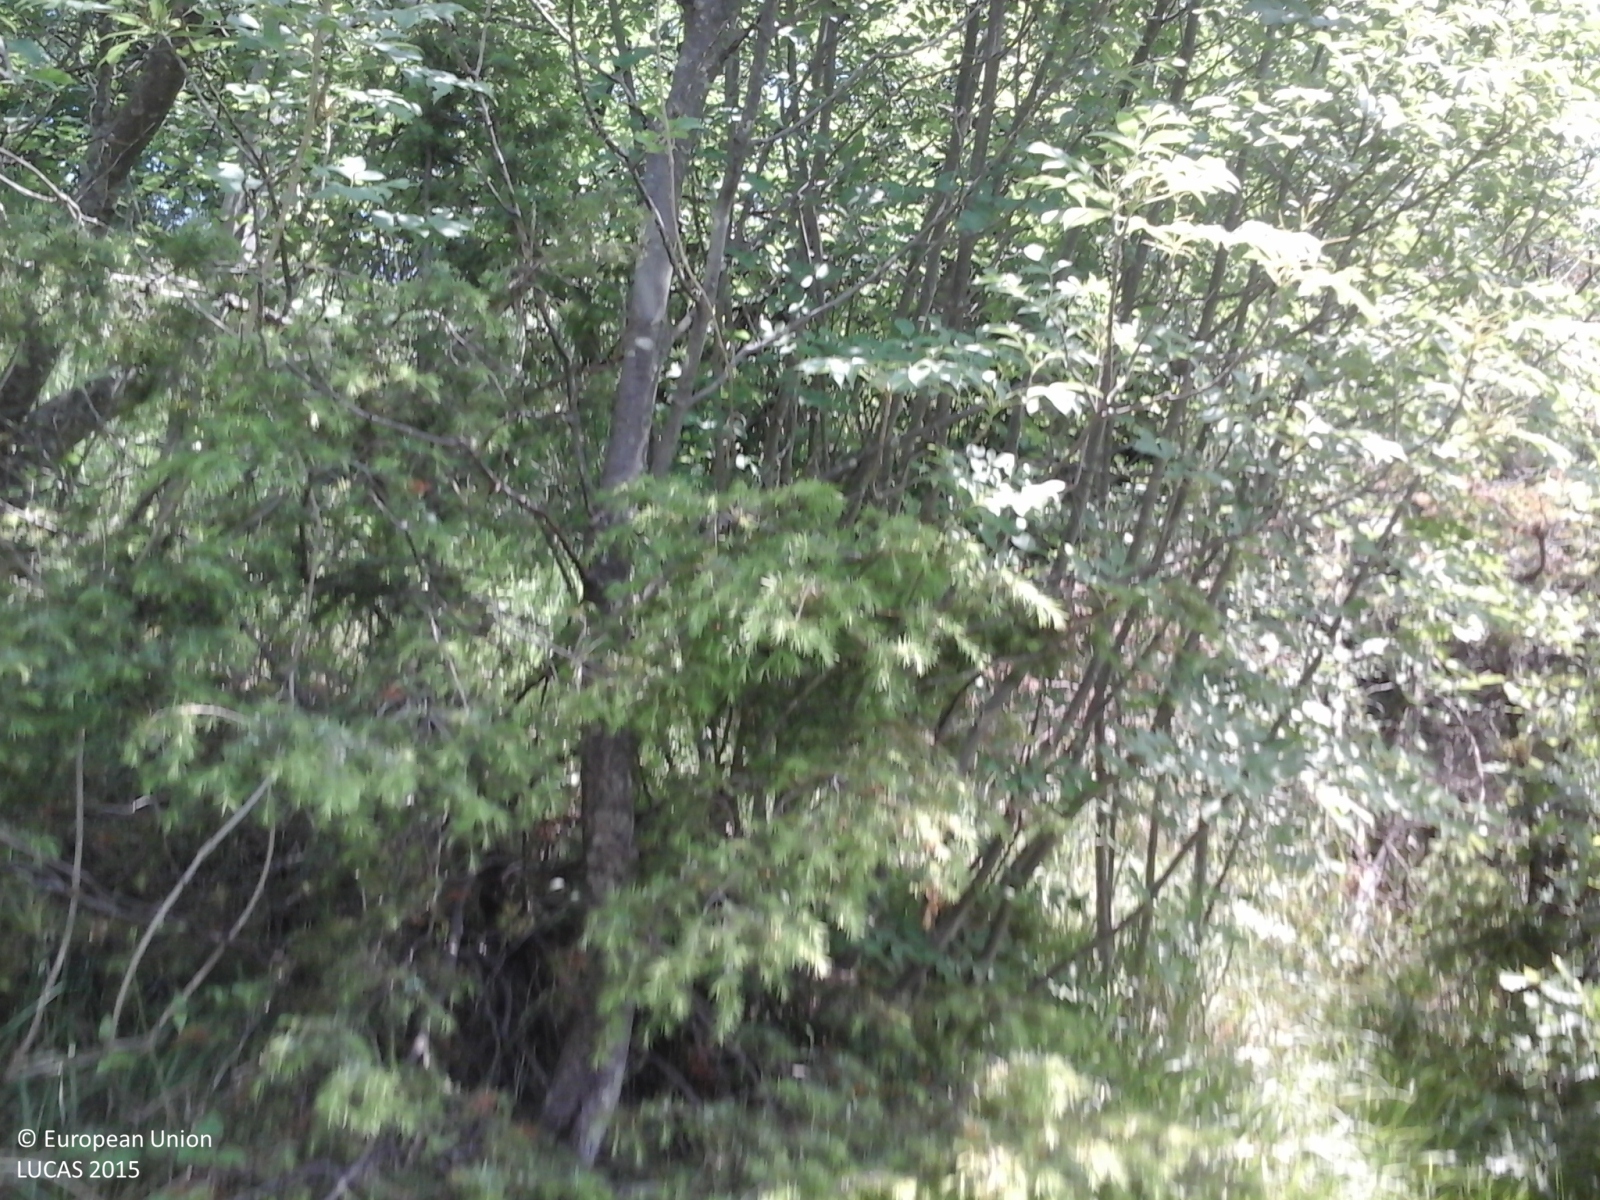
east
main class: Woodland
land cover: Broadleaved woodland
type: mesophytic deciduous forest
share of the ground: > 75 %
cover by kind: broadleaved forest trees 80 %, herbaceous plants 20 %
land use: Forestry
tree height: > 5 m
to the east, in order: Broadleaved woodland; Paved roads, cycling and walking lanes; Broadleaved woodland; Tracks; Broadleaved woodland; Tracks; Broadleaved woodland; Tracks; Broadleaved woodland
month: May
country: IT
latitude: 44.1454
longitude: 11.1848
